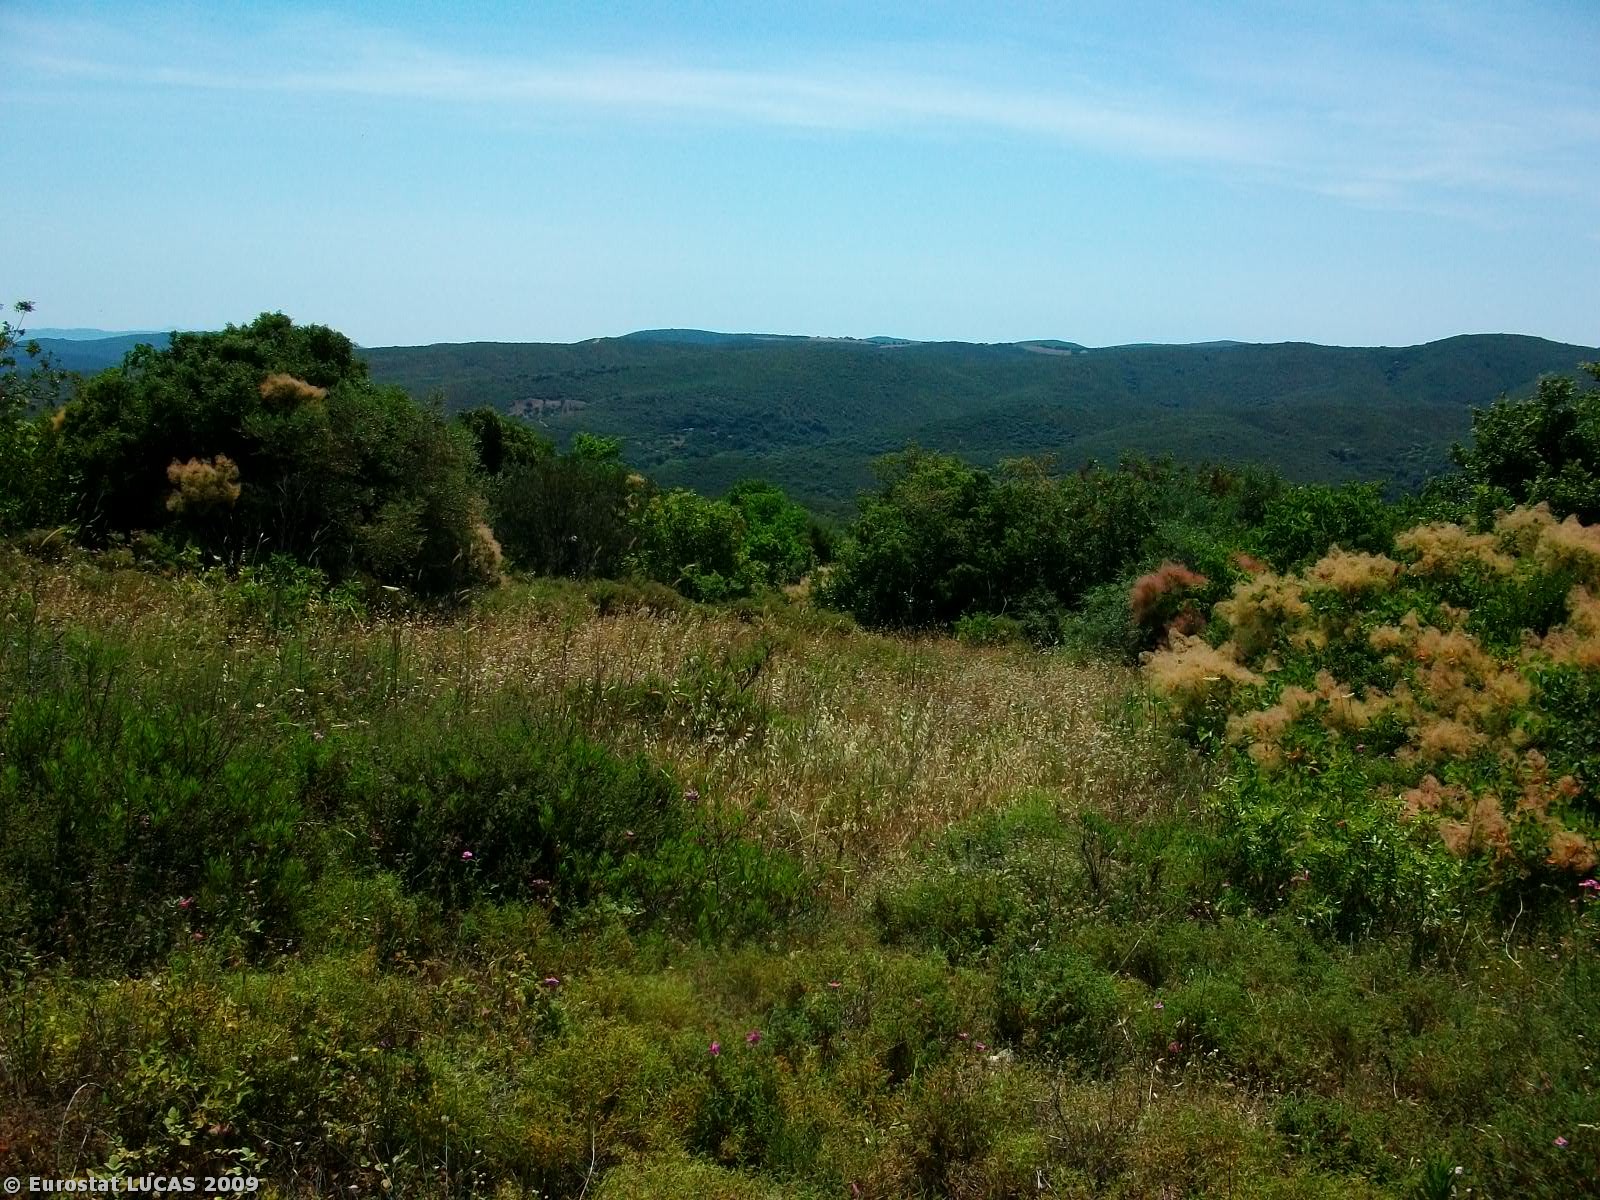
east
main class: Shrubland
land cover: Shrubland without tree cover
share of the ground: > 75 %
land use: Unused
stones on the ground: > 50 %
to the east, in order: Shrubland without tree cover; Olive groves; Shrubland with sparse tree cover; Shrubland without tree cover; Grass margins
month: June
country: GR
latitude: 39.2203
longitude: 23.2316
